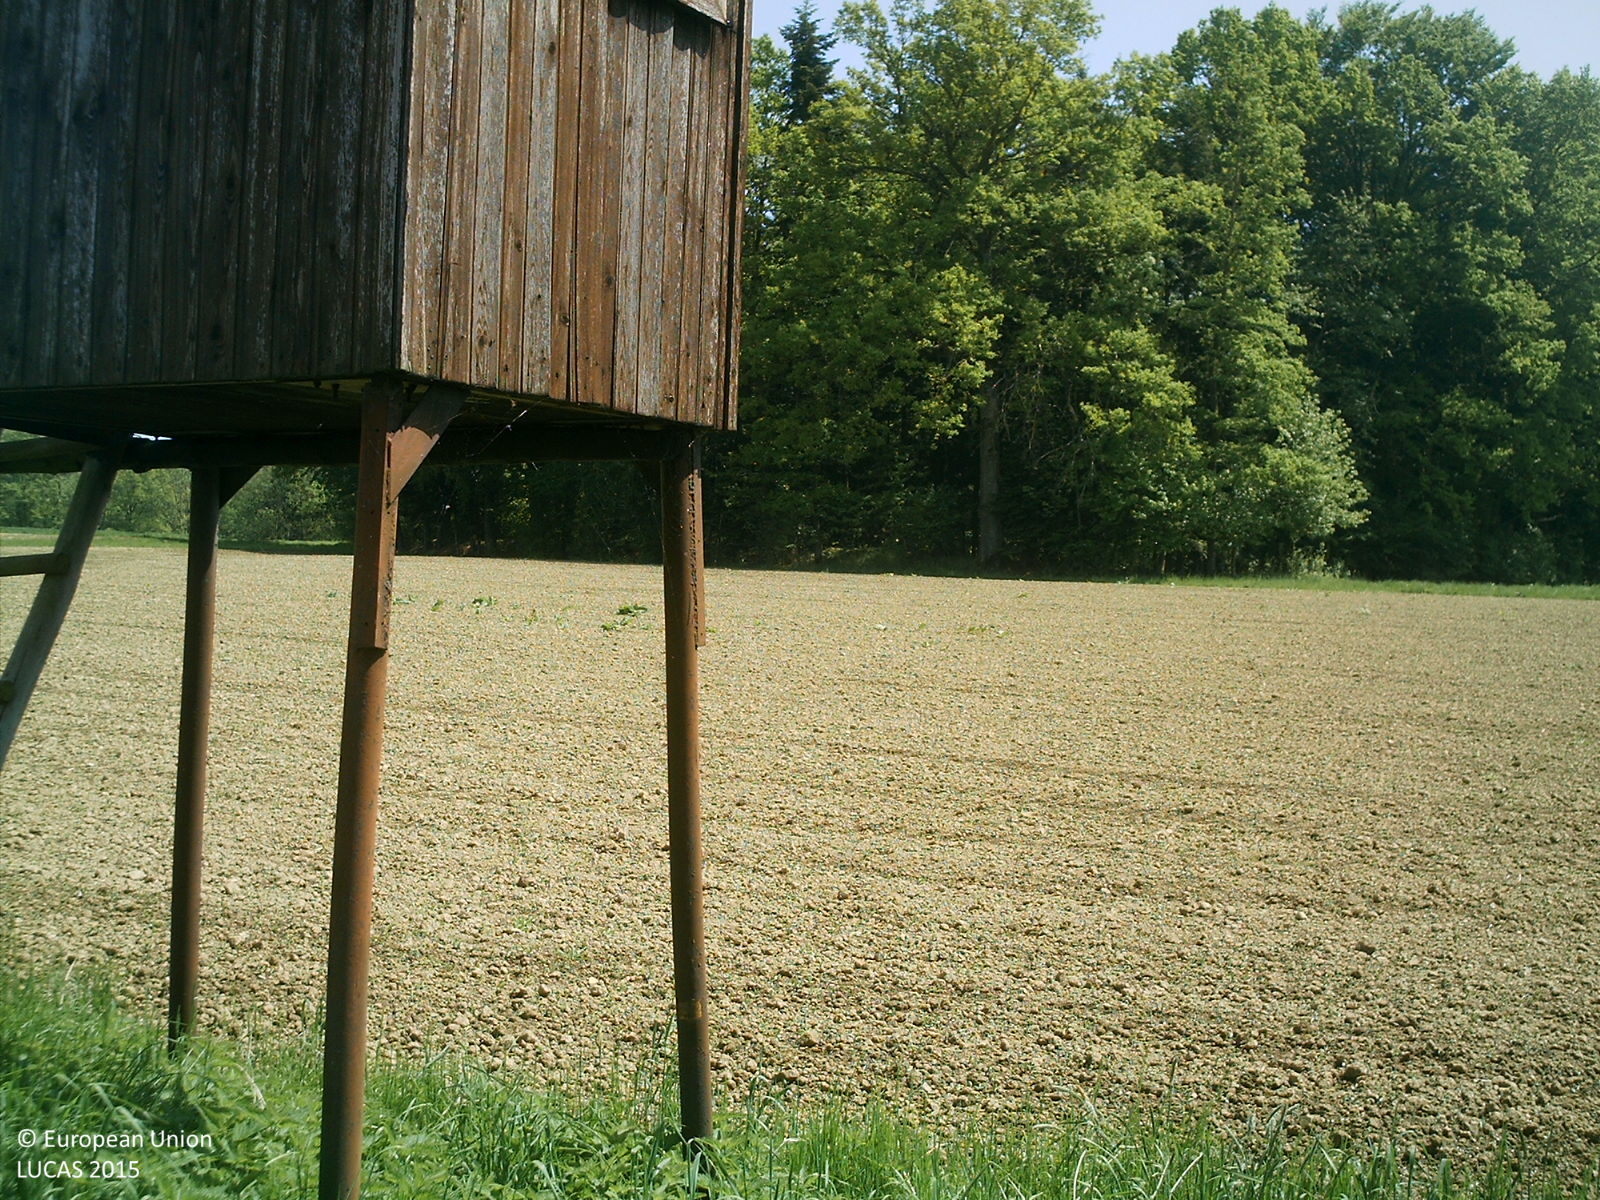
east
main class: Grassland
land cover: Spontaneously vegetated surfaces
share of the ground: > 75 %
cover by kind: herbaceous plants 100 %
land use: Fallow land
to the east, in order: Spontaneously vegetated surfaces; Dry pulses; Tracks; Spruce dominated mixed woodland; Other mixed woodland; Tracks; Other mixed woodland; Ditches and canals; Spruce dominated mixed woodland
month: May
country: AT
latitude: 47.9837
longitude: 14.1396
